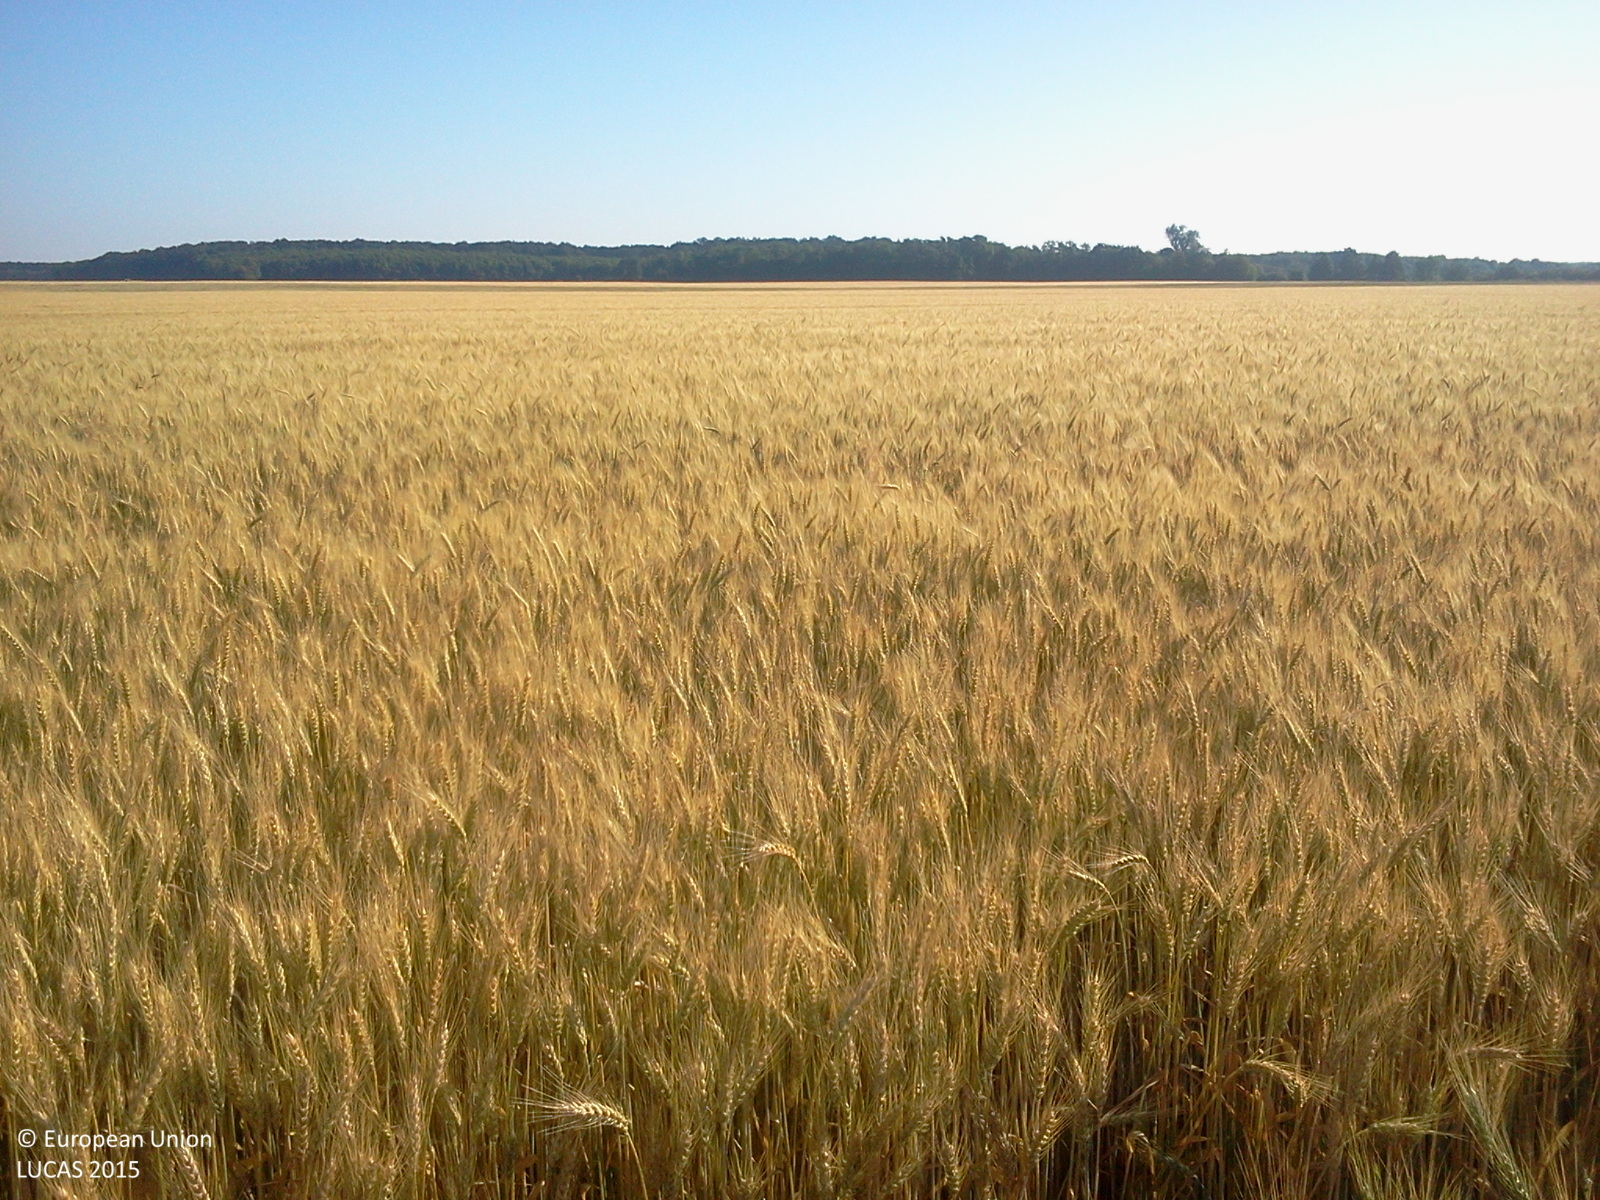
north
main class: Cropland
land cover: Durum wheat
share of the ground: > 75 %
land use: Agriculture (excluding fallow land and kitchen gardens)
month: June
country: HU
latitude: 47.0515
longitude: 17.1531
